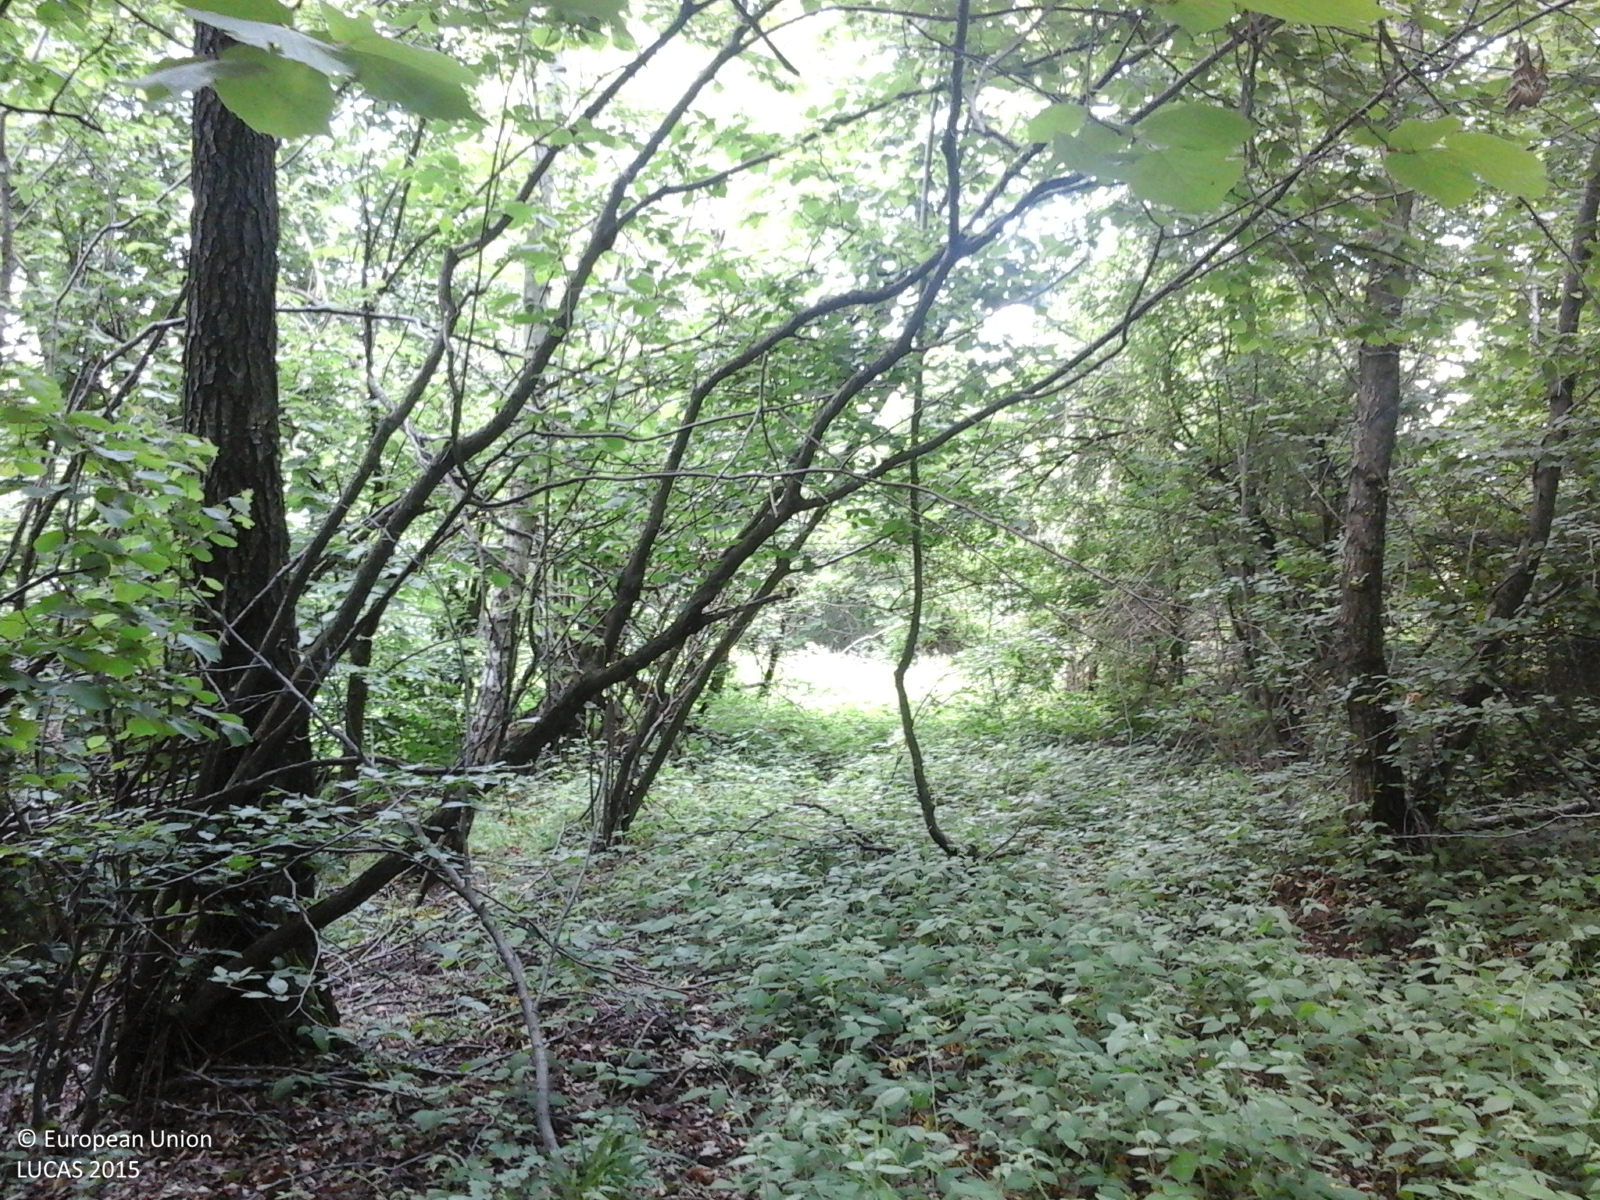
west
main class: Woodland
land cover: Broadleaved woodland
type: beech forest
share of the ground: > 75 %
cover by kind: broadleaved forest trees 100 %
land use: Forestry
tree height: > 5 m
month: May
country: RO
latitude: 45.7968
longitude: 25.2663
